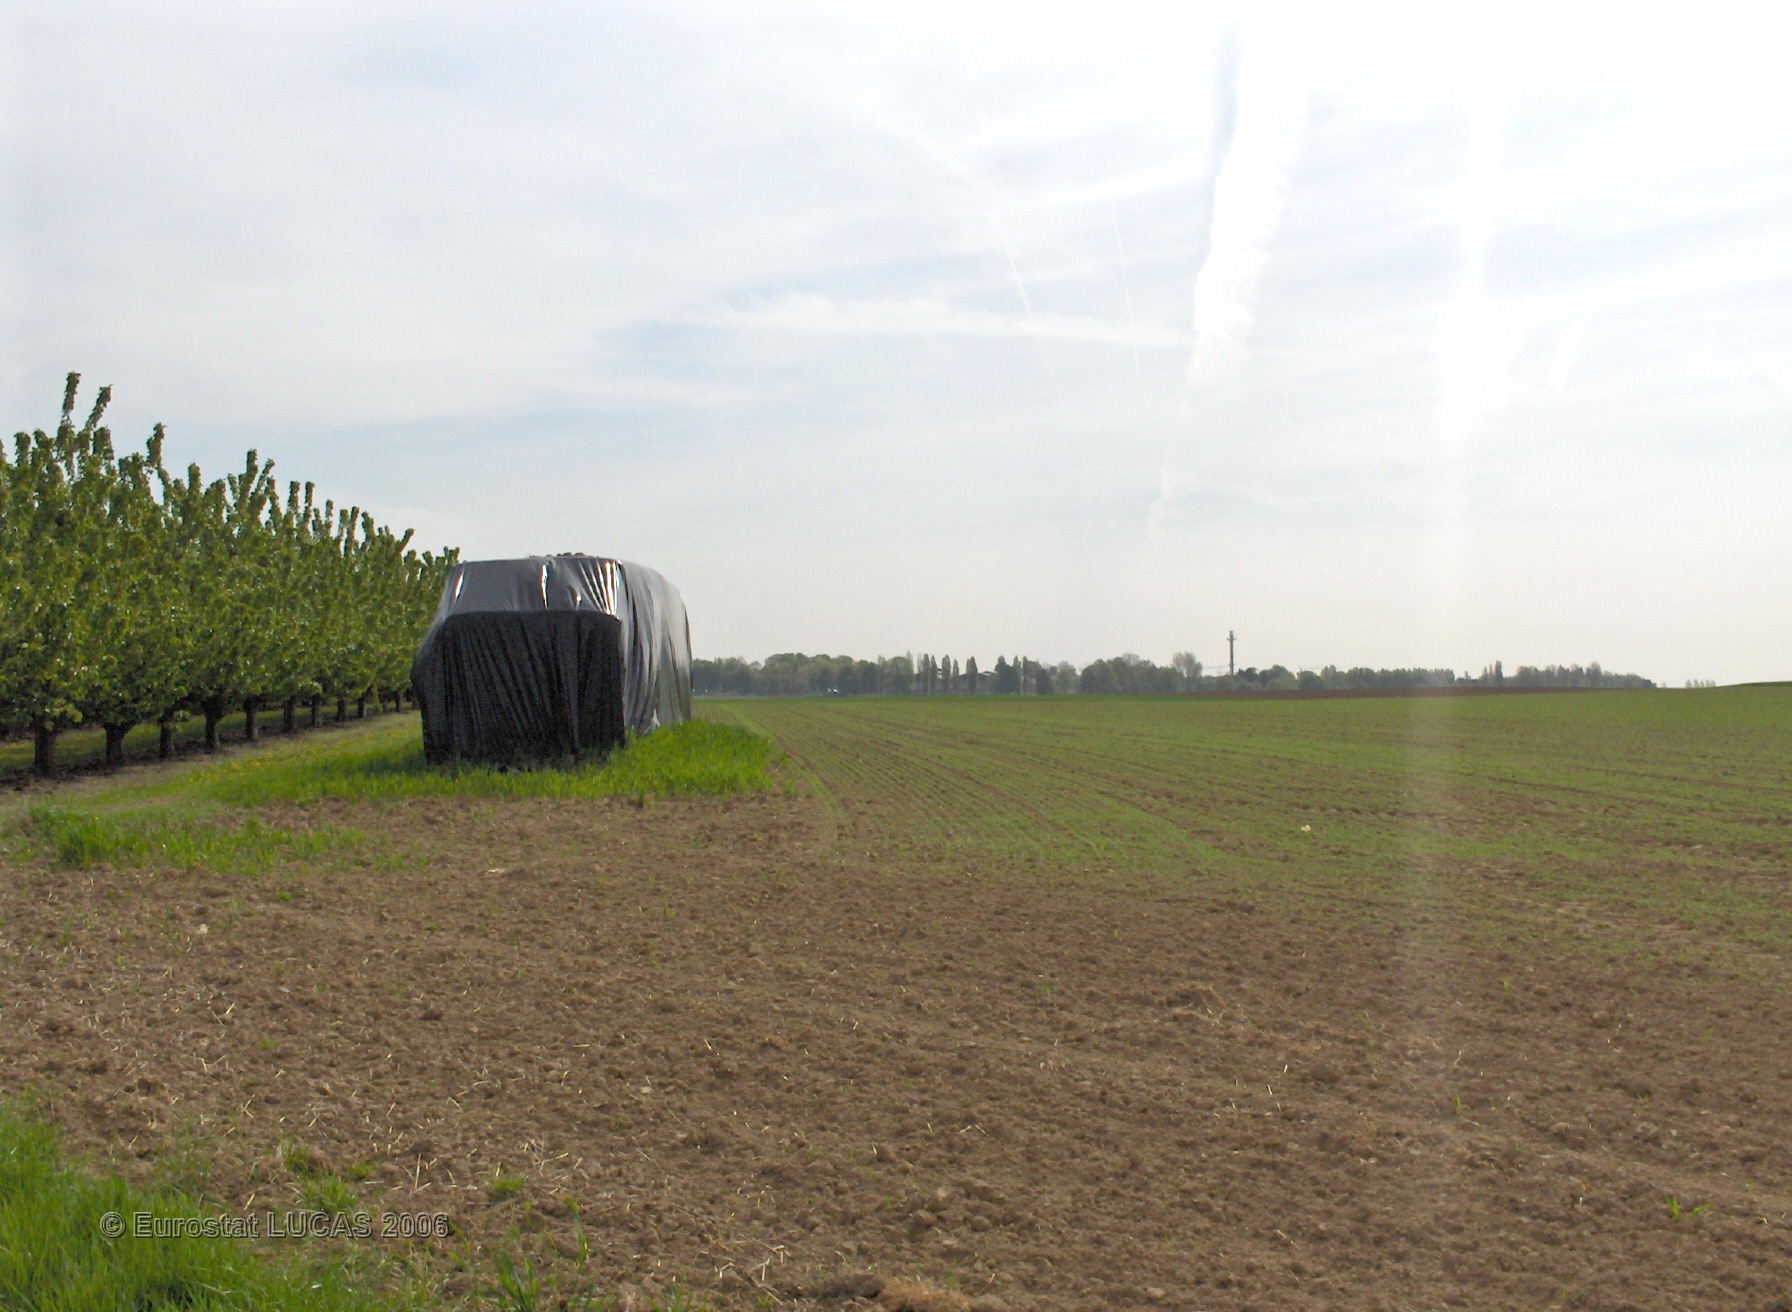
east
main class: Cropland
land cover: Other fibre and oleaginous crops
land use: Agriculture (excluding fallow land and kitchen gardens)
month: May
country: BE
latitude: 50.7864
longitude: 5.2174
